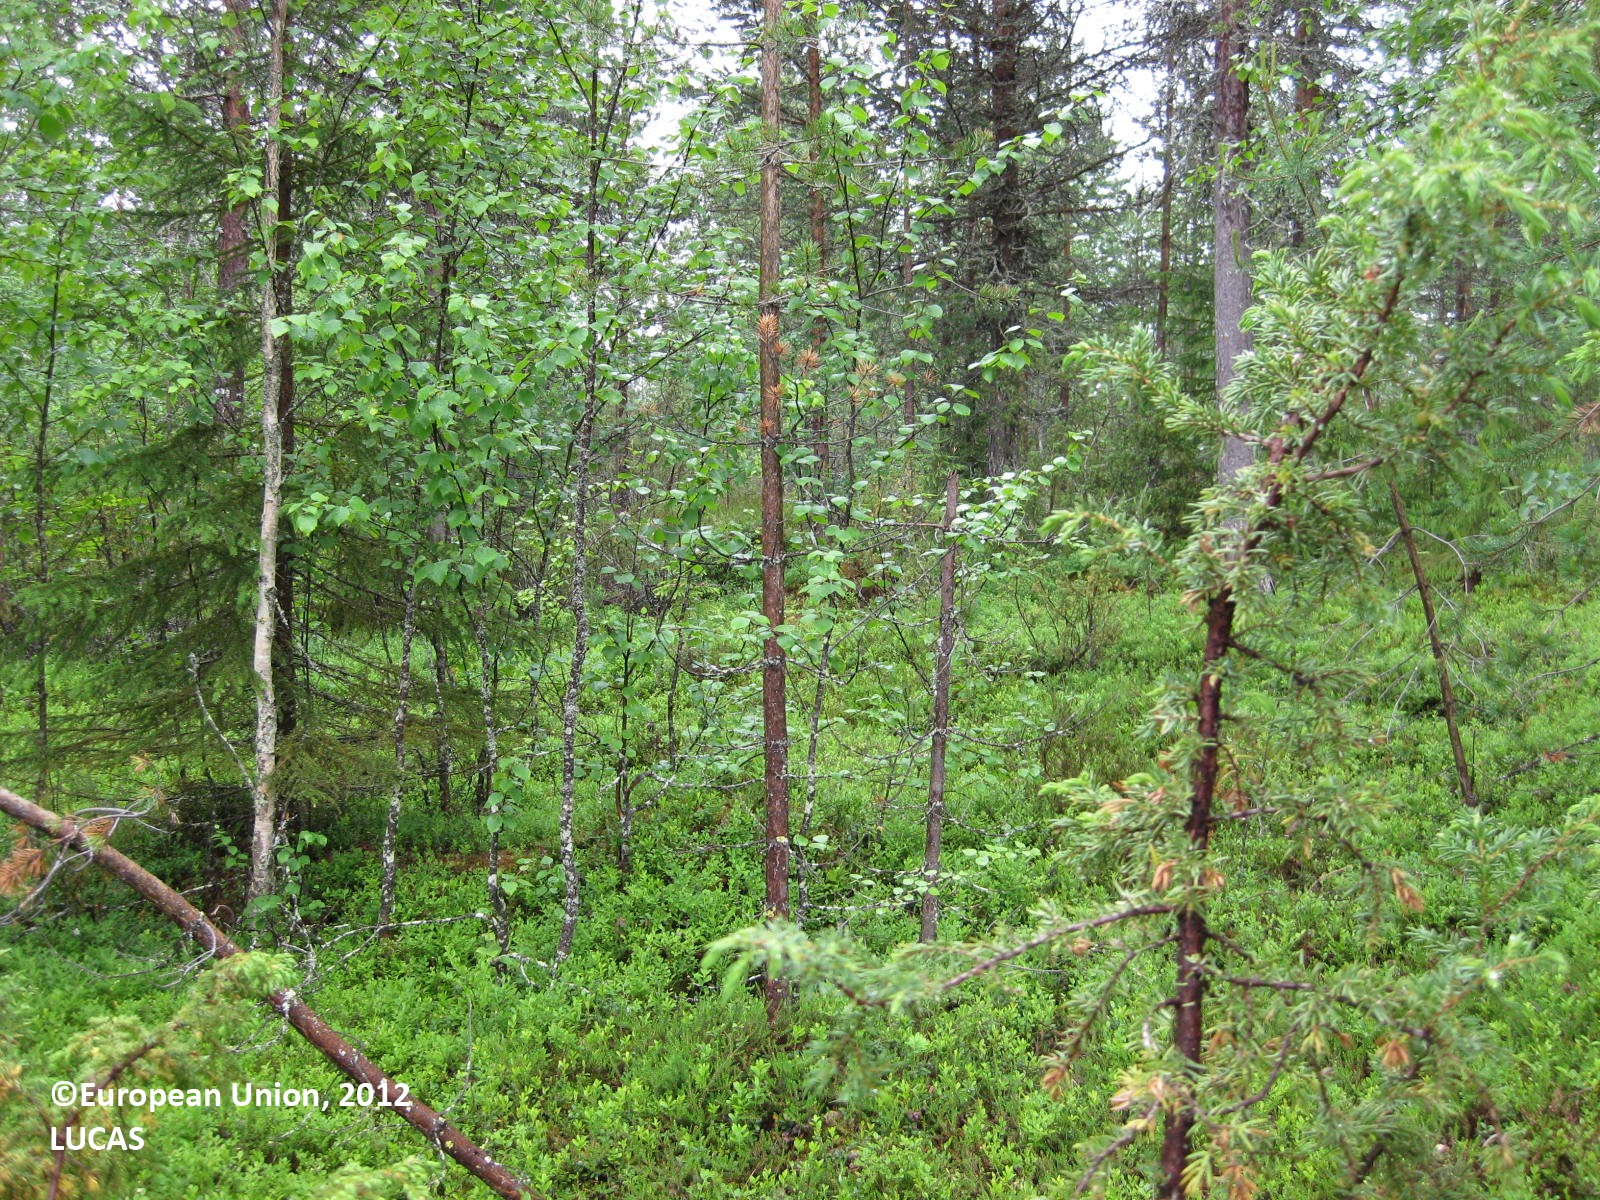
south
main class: Woodland
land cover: Pine dominated mixed woodland
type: boreal forest
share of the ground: > 75 %
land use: Forestry
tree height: > 5 m
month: July
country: FI
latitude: 65.4577
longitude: 28.2118
